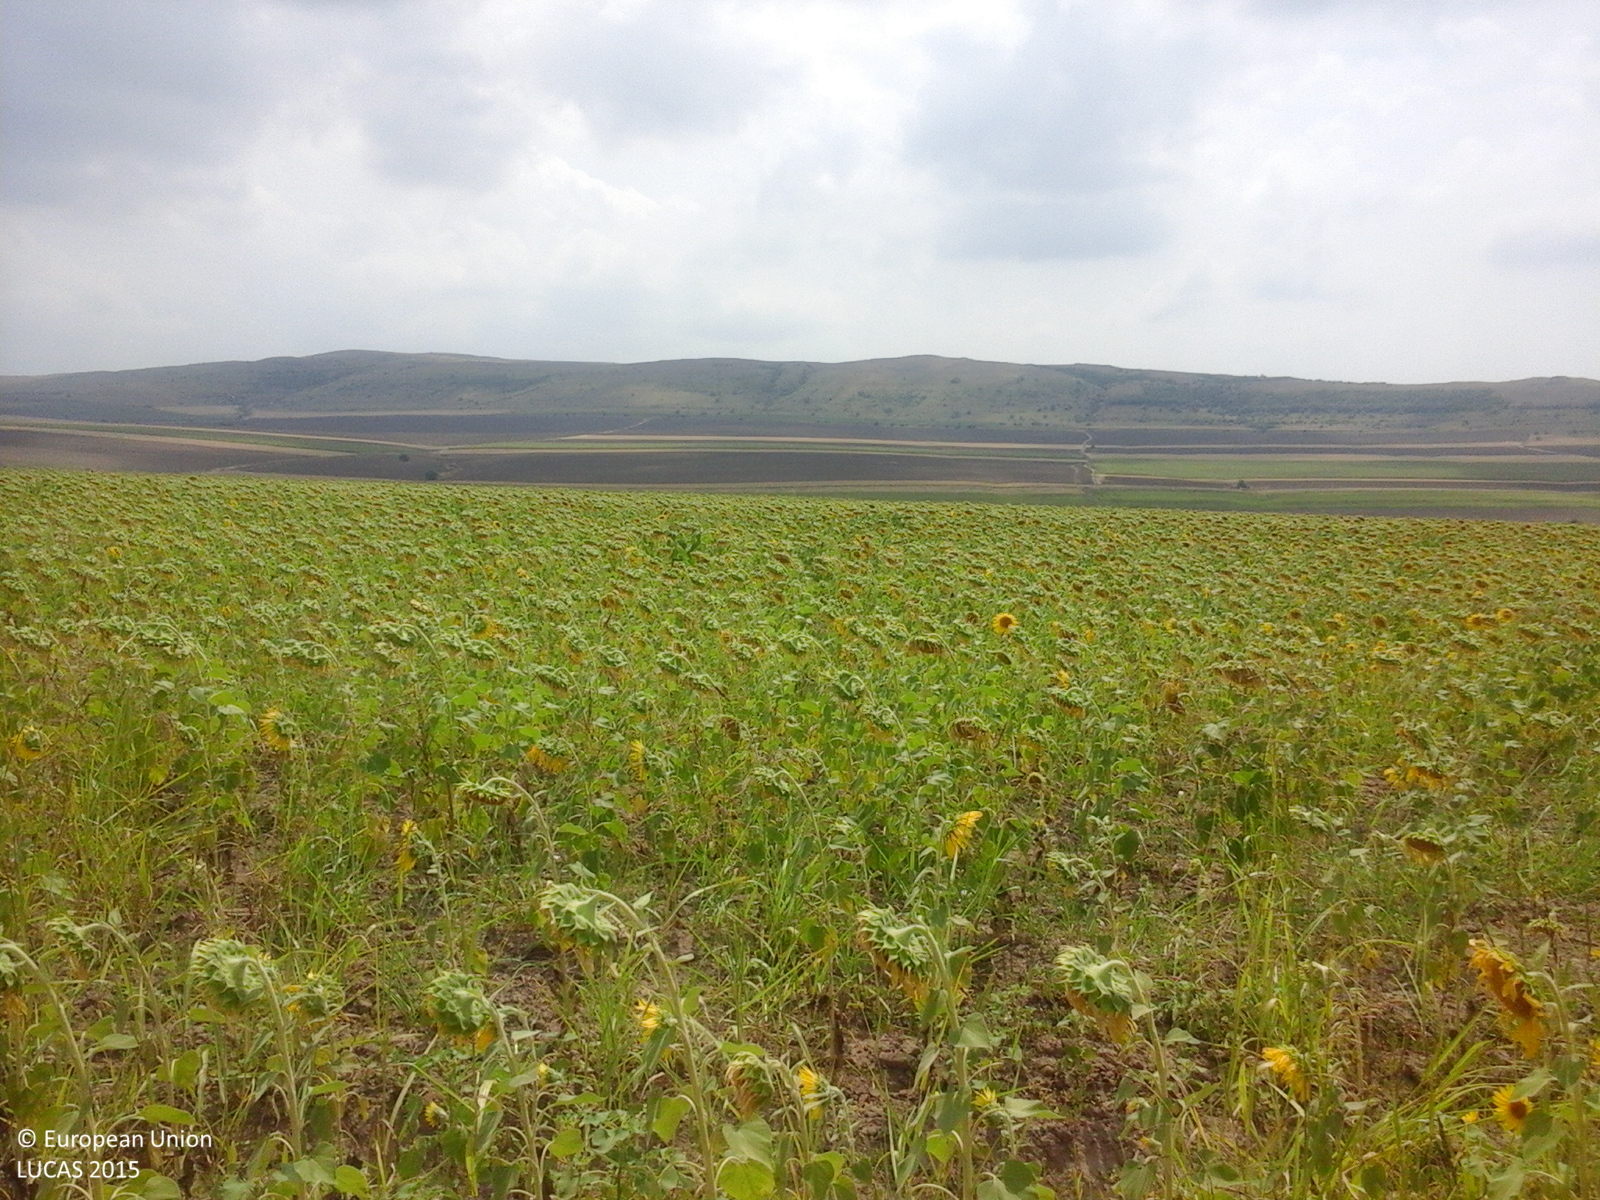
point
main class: Cropland
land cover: Sunflower
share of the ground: > 75 %
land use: Agriculture (excluding fallow land and kitchen gardens)
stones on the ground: < 10 %
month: July
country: RO
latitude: 44.9861
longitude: 28.2441
